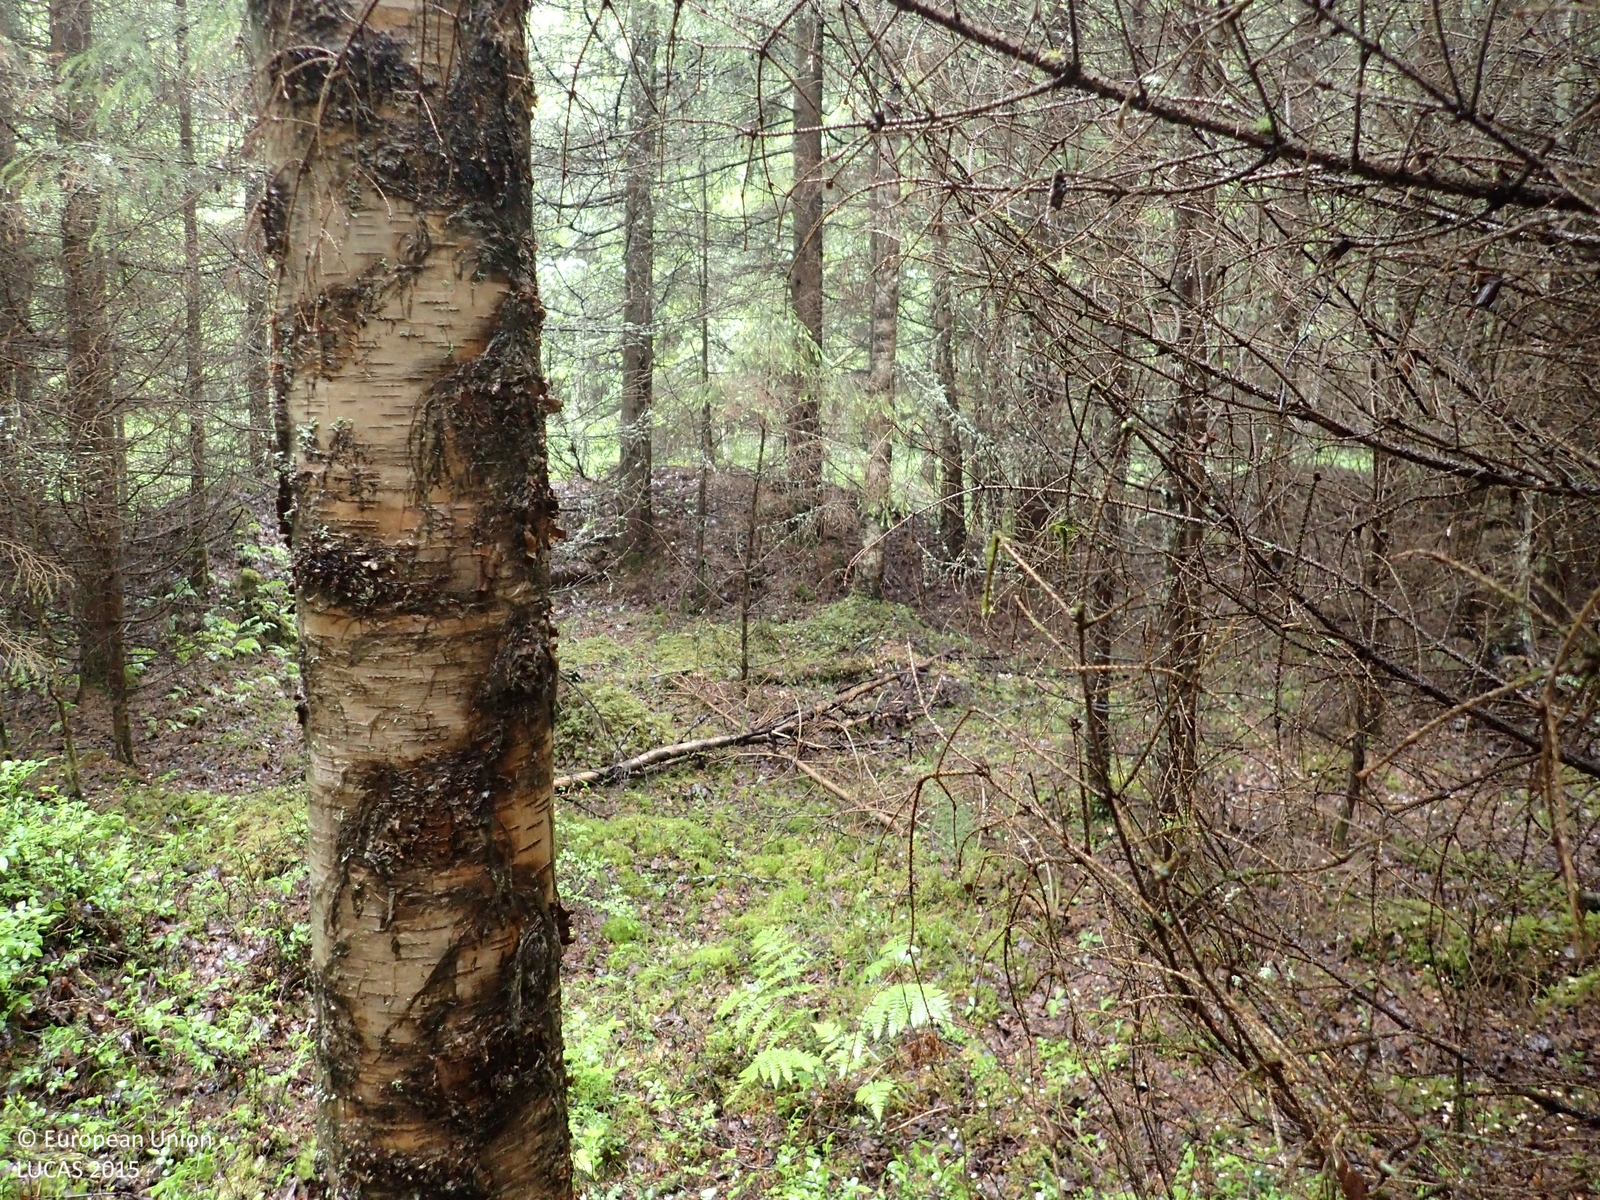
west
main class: Woodland
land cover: Spruce dominated mixed woodland
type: boreal forest
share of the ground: > 75 %
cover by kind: coniferous forest trees 65 %, broadleaved forest trees 25 %, shrubs 5 %, herbaceous plants 5 %
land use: Forestry
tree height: > 5 m
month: June
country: FI
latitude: 62.2938
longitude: 21.5554
